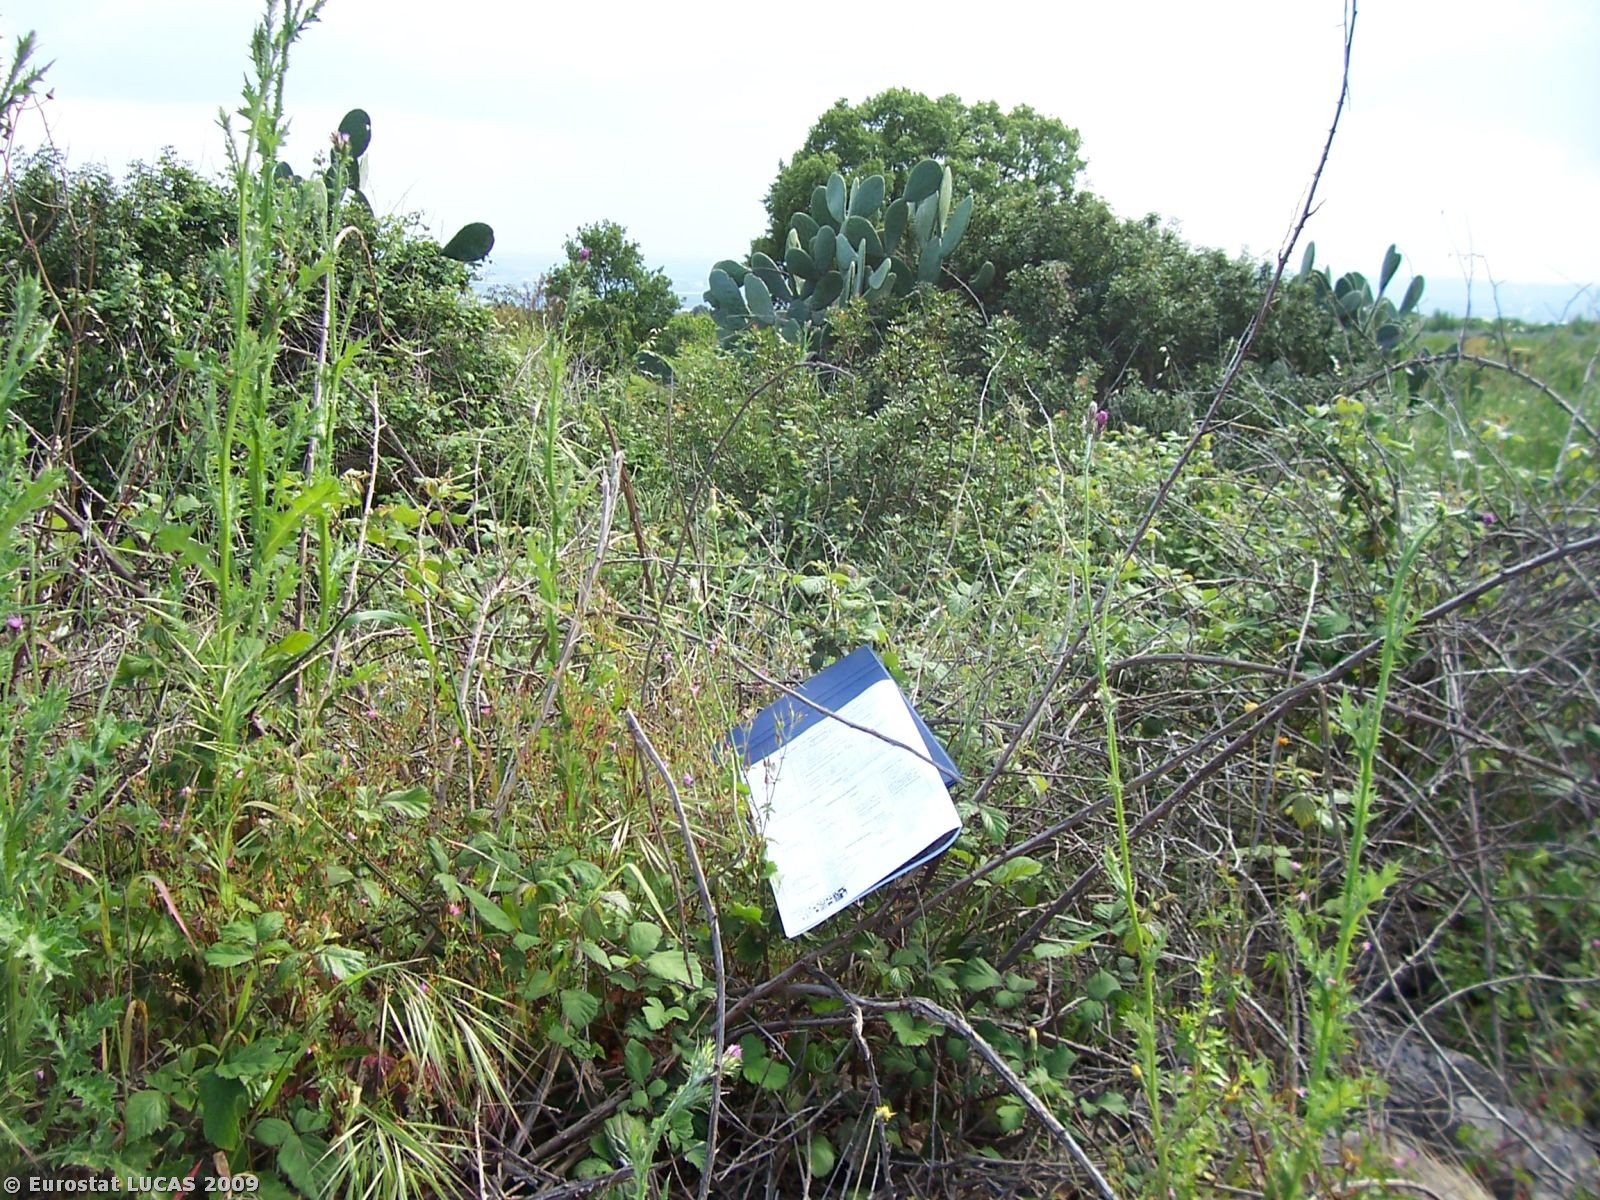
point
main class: Shrubland
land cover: Shrubland without tree cover
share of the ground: > 75 %
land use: Nature reserves
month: May
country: IT
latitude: 40.5911
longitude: 16.8413
